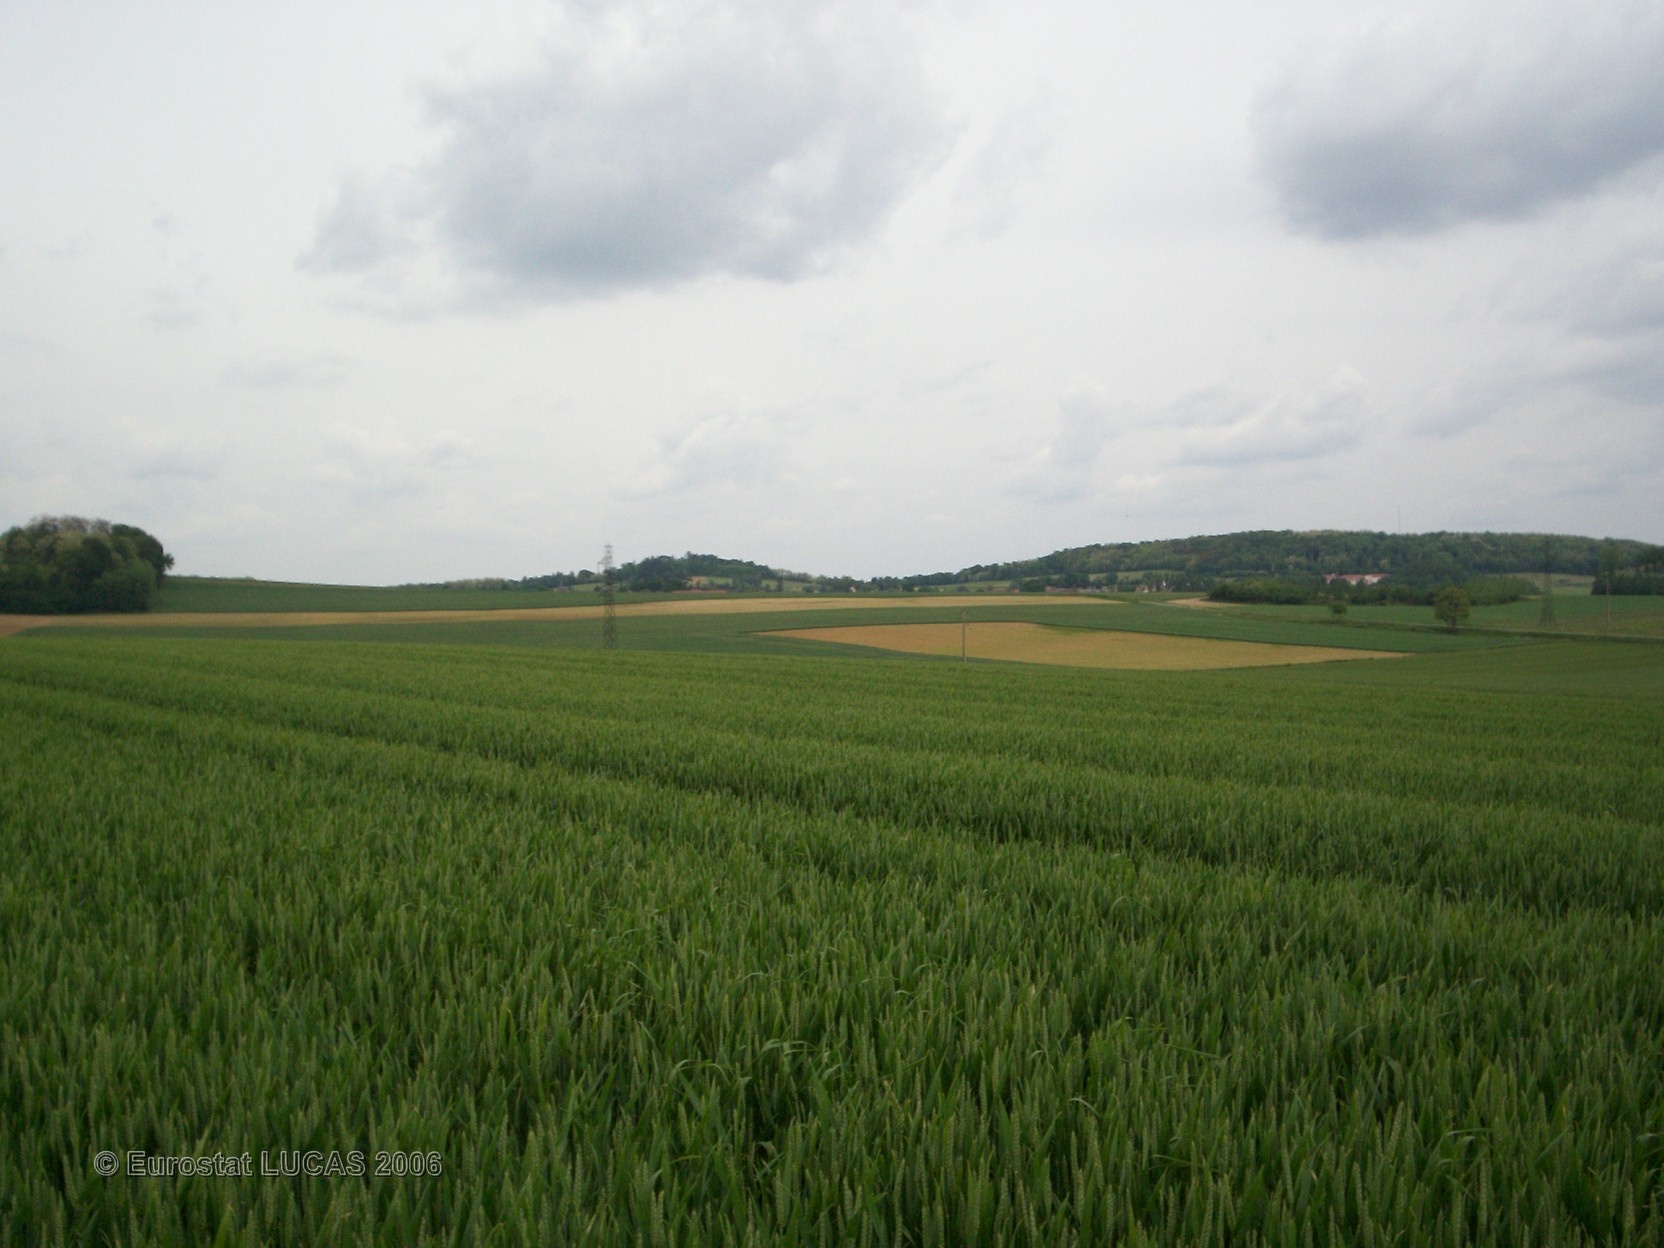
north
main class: Cropland
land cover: Common wheat
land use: Agriculture (excluding fallow land and kitchen gardens)
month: June
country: FR
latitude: 49.3743
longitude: 2.7312
